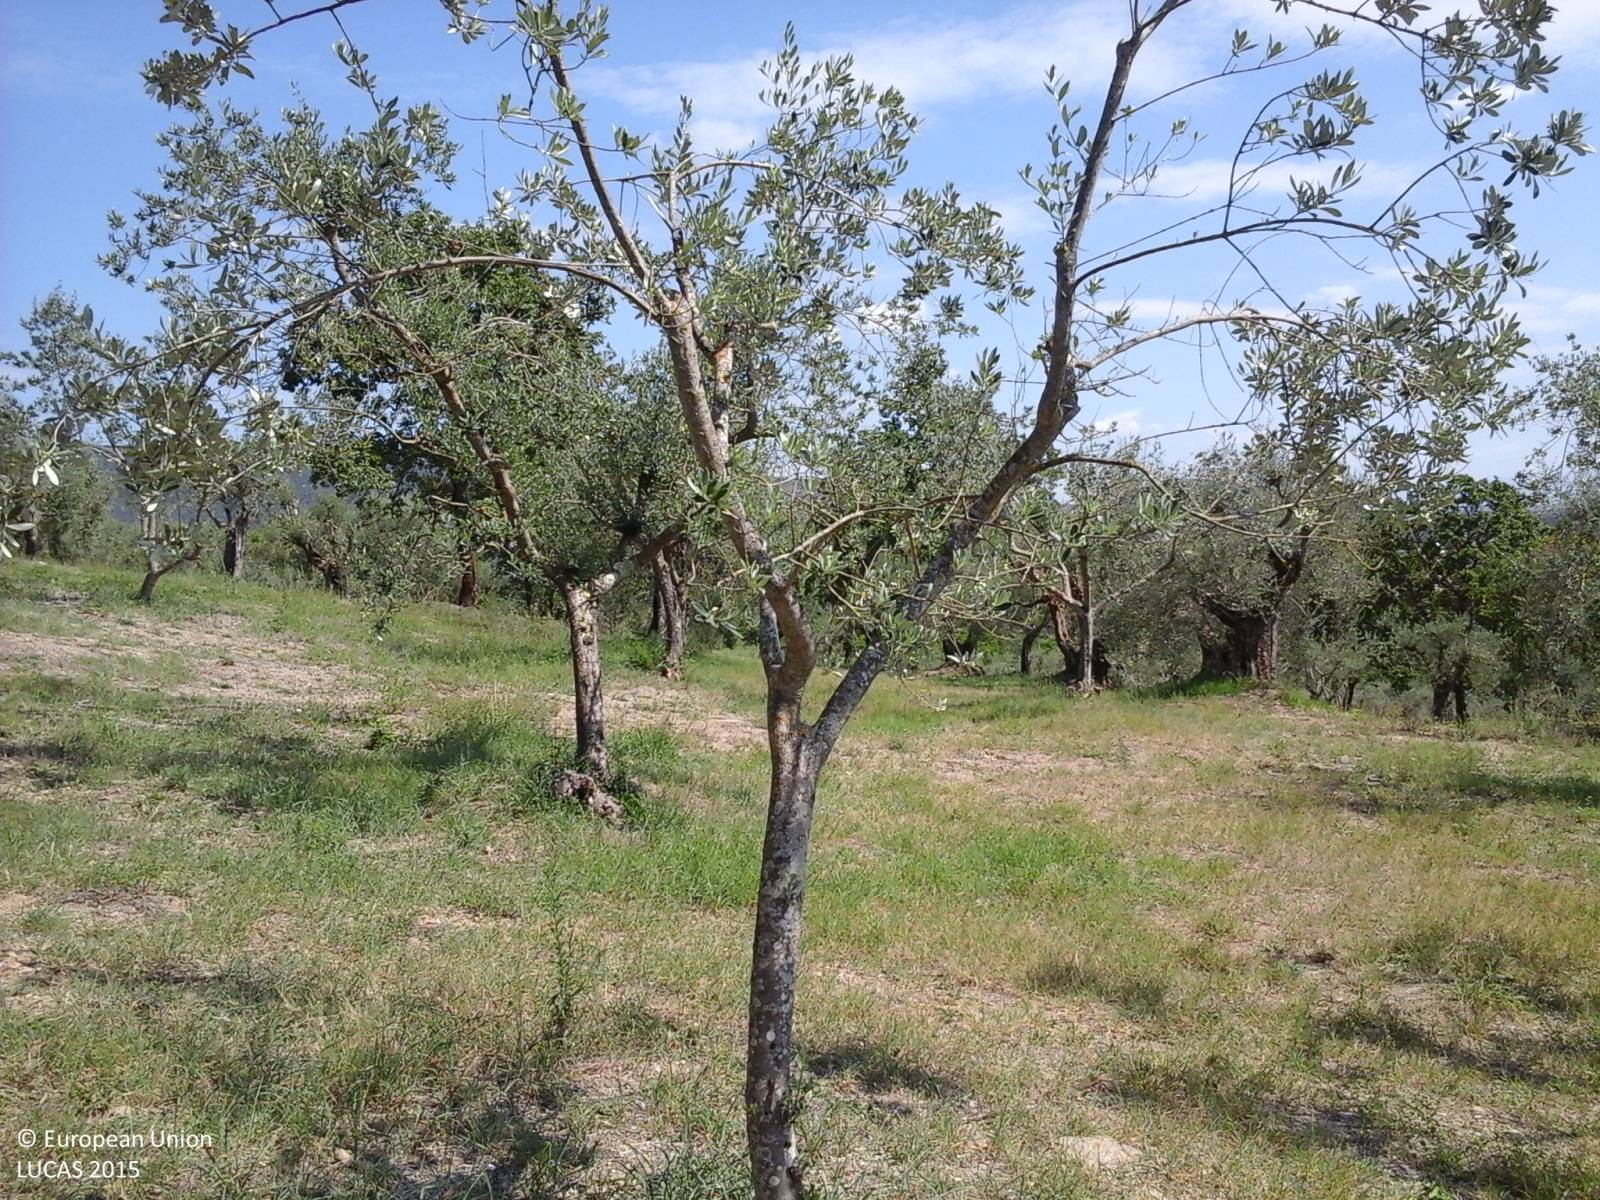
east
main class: Cropland
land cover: Olive groves
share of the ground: 25 - 50 %
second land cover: Grassland without tree/shrub cover
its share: > 75 %
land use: Agriculture (excluding fallow land and kitchen gardens)
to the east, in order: Olive groves; Grassland without tree/shrub cover; Tracks; Electric lines; Vineyards; Grass margins; Tracks; Rocks and stones; Ditches and canals; Olive groves; Grass margins; Paved roads, cycling and walking lanes; Grass margins; Olive groves
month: September
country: IT
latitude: 43.1164
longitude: 12.2670
